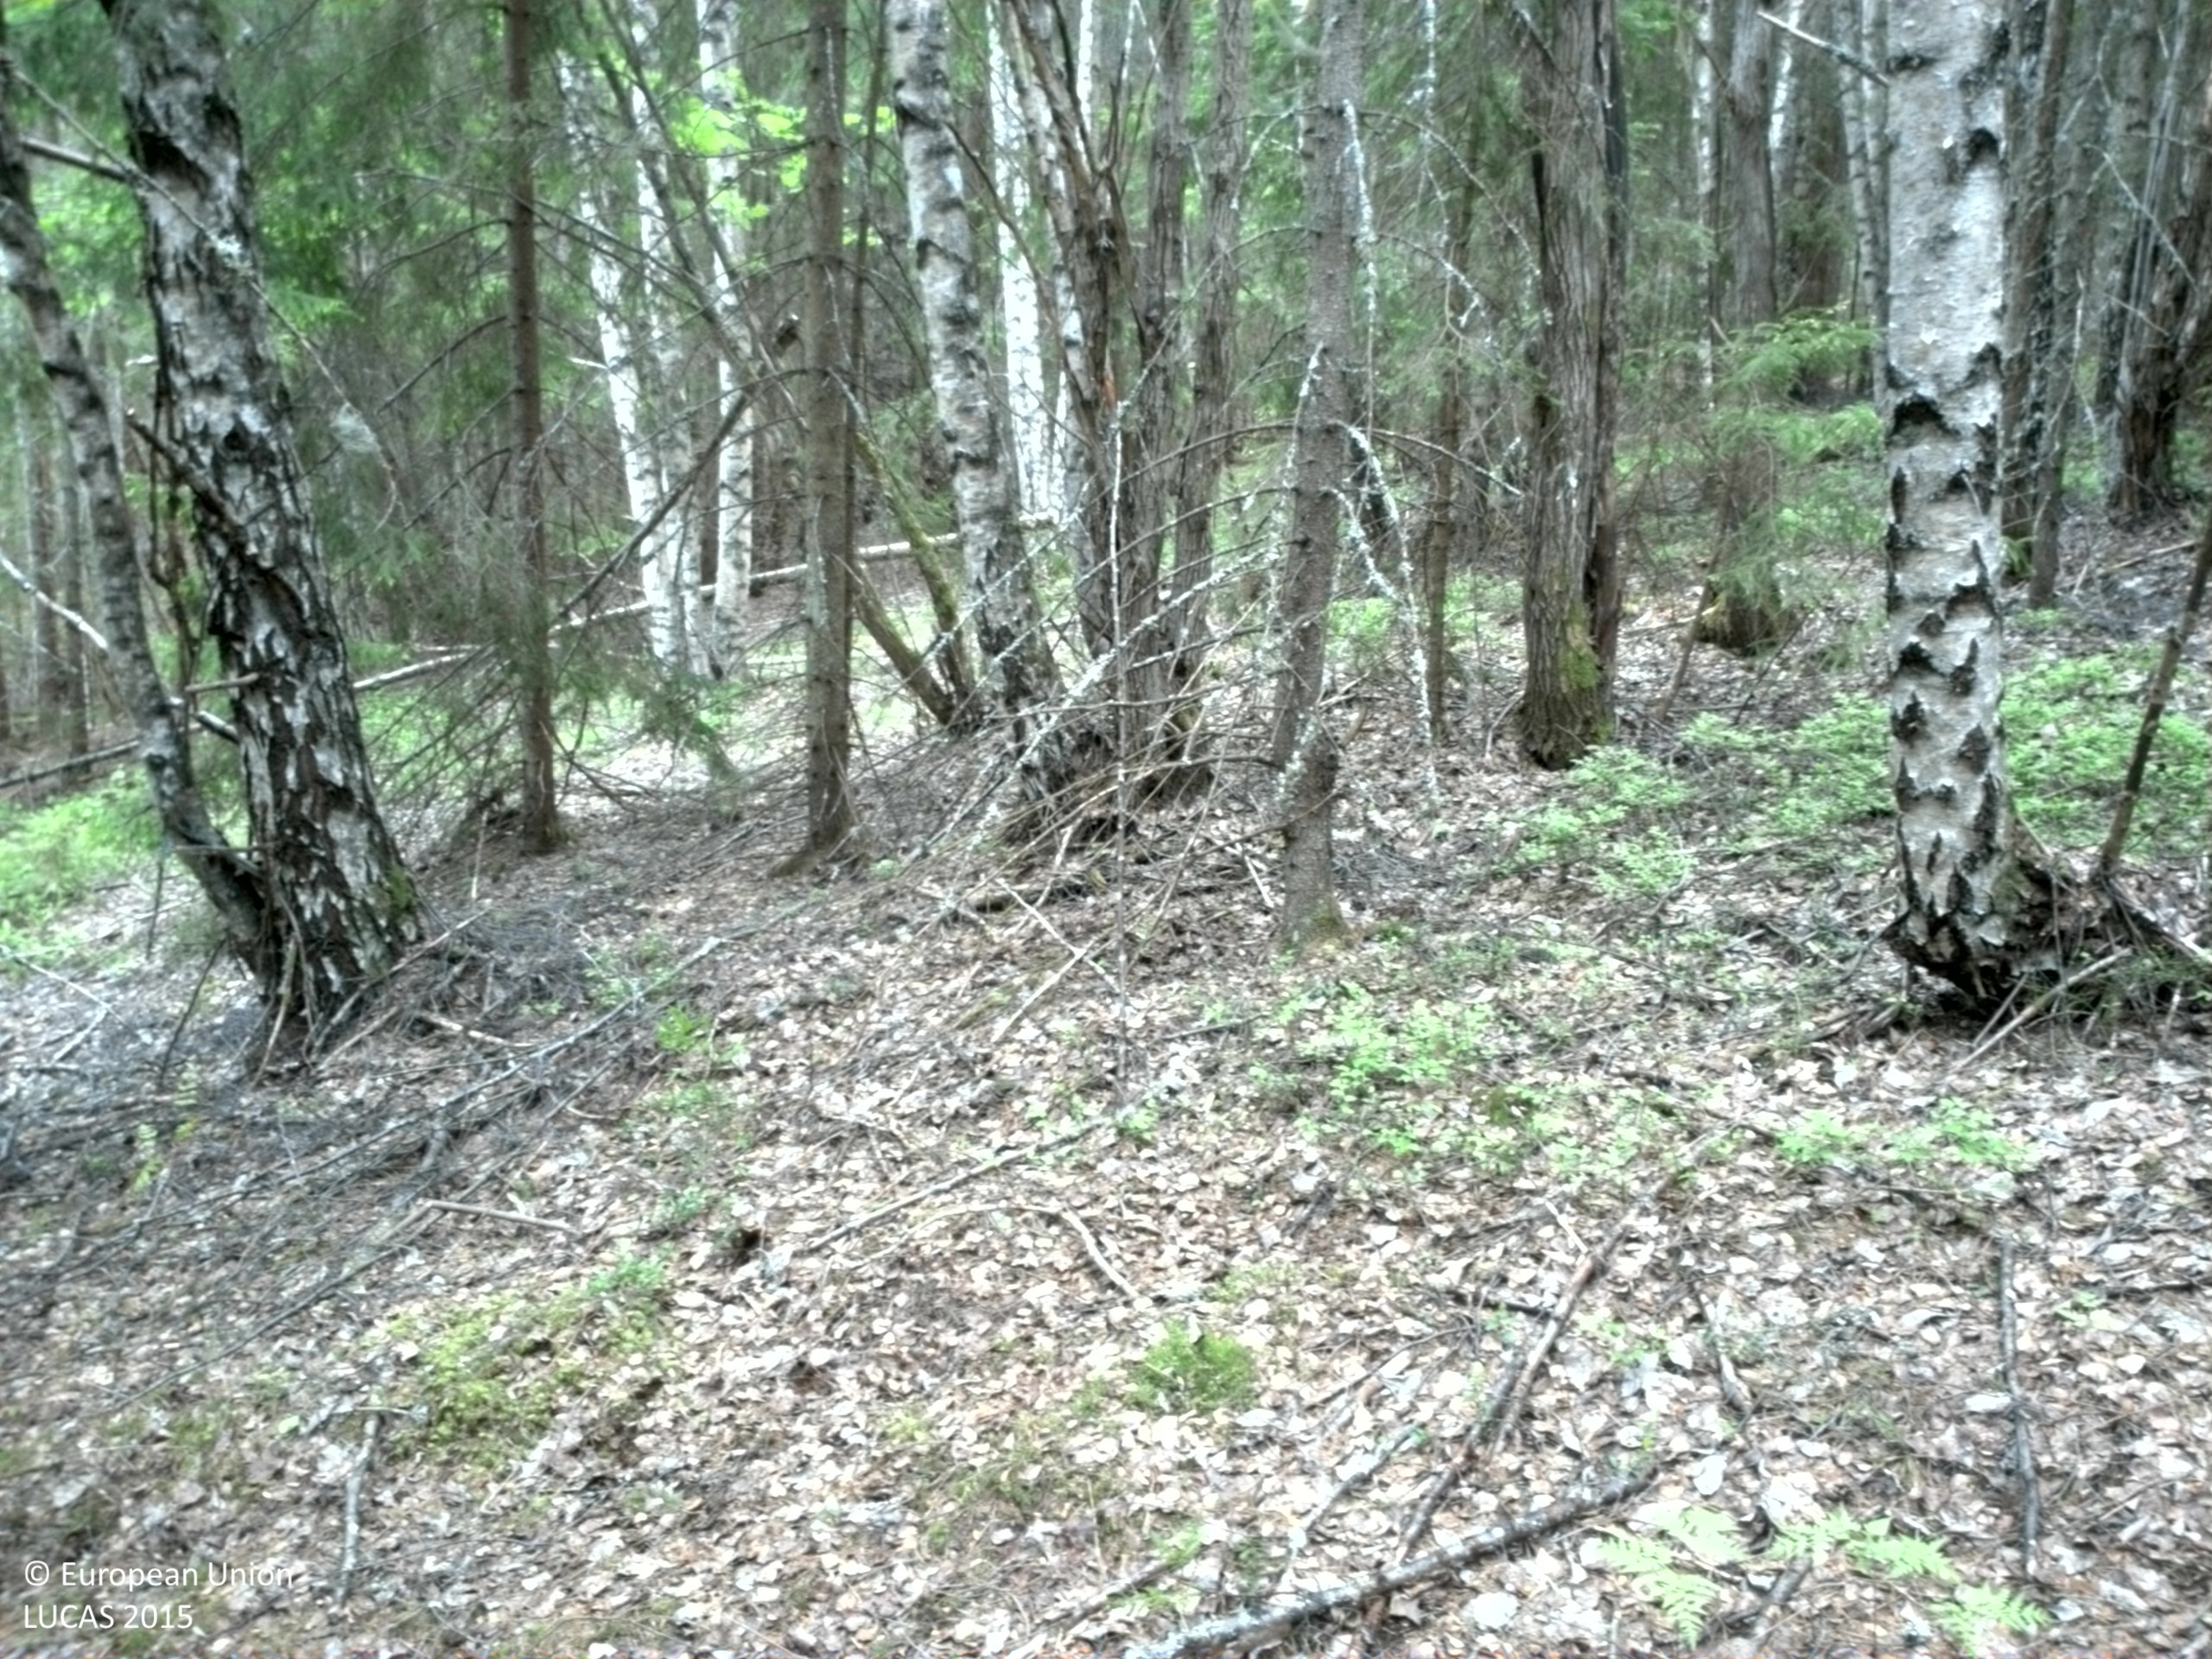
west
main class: Woodland
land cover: Spruce dominated coniferous woodland
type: boreal forest
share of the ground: > 75 %
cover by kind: coniferous forest trees 80 %, herbaceous plants 10 %, broadleaved forest trees 5 %, unconsolidated bare surface 5 %
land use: Forestry
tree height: > 5 m
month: June
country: SE
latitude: 62.9519
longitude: 17.8428
